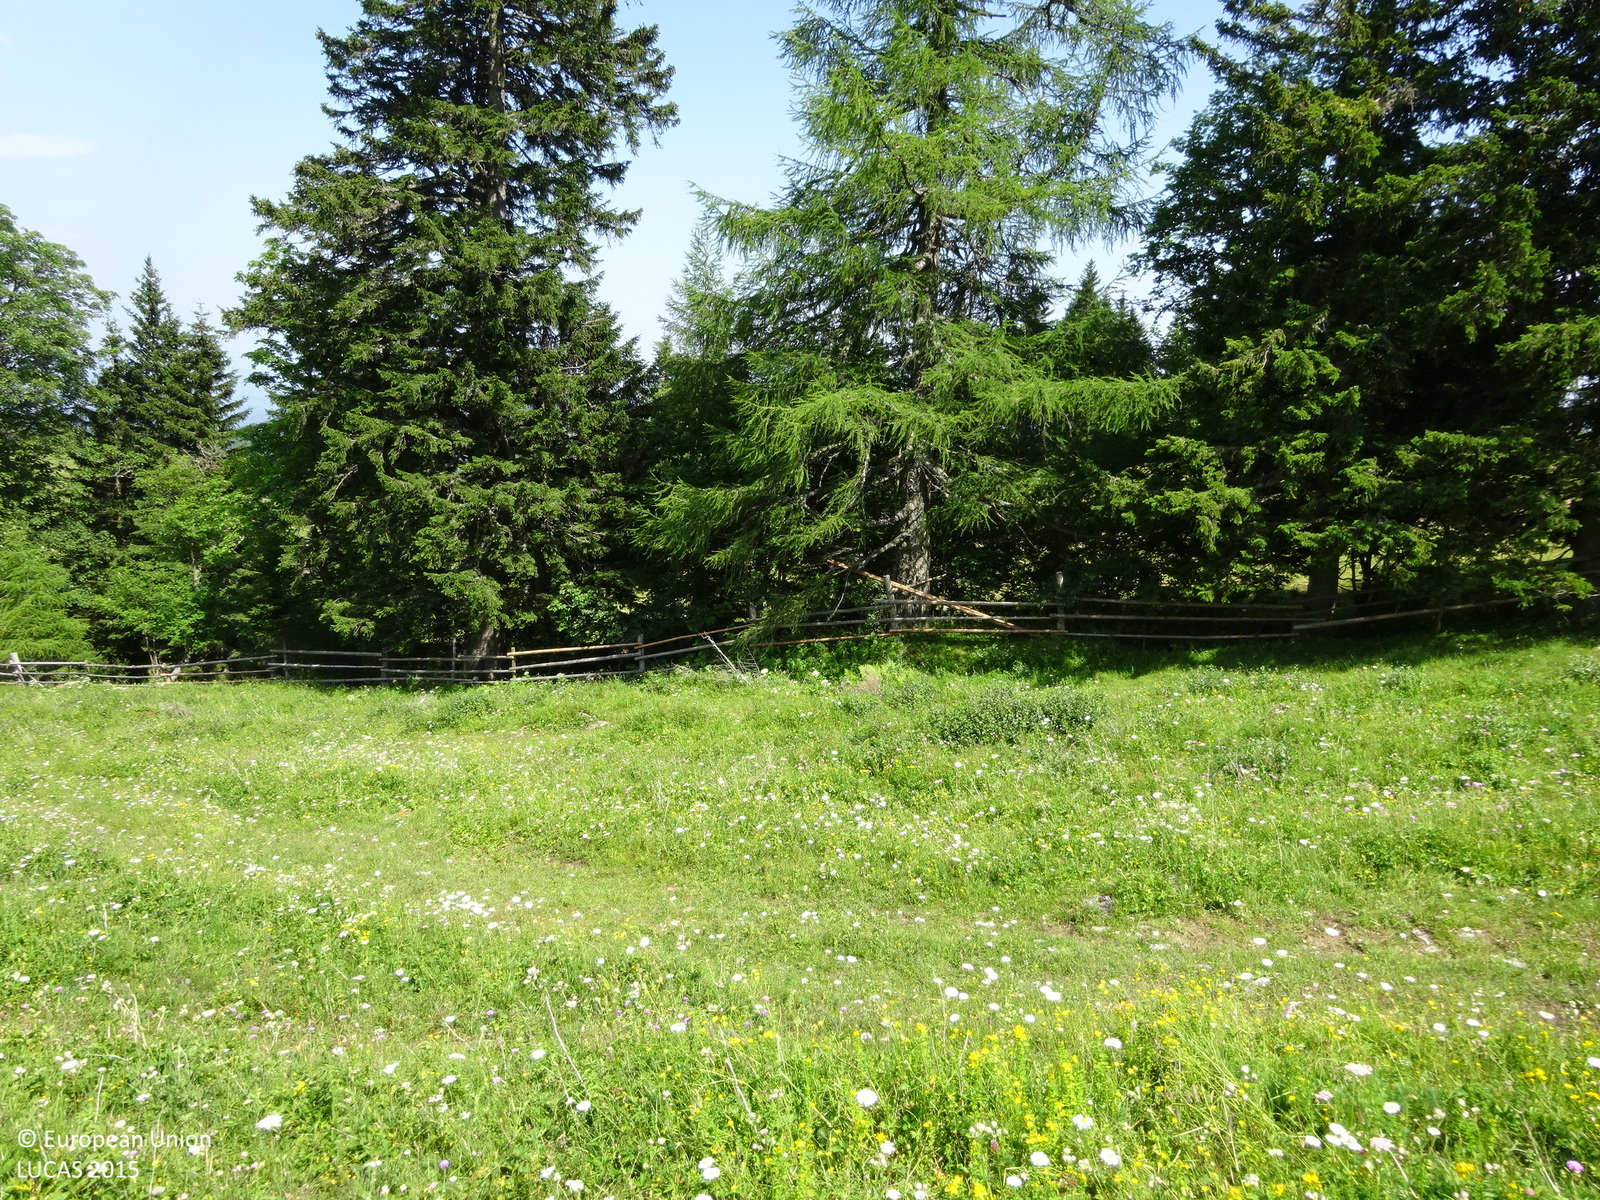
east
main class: Grassland
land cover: Grassland without tree/shrub cover
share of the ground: > 75 %
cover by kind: herbaceous plants 100 %
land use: Agriculture (excluding fallow land and kitchen gardens)
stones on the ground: < 10 %
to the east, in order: Grassland without tree/shrub cover; Fences; Spruce dominated mixed woodland; Grassland without tree/shrub cover; Fences; Other bare soil; Fences; Grassland without tree/shrub cover; Tracks
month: July
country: AT
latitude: 47.0851
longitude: 14.9385
